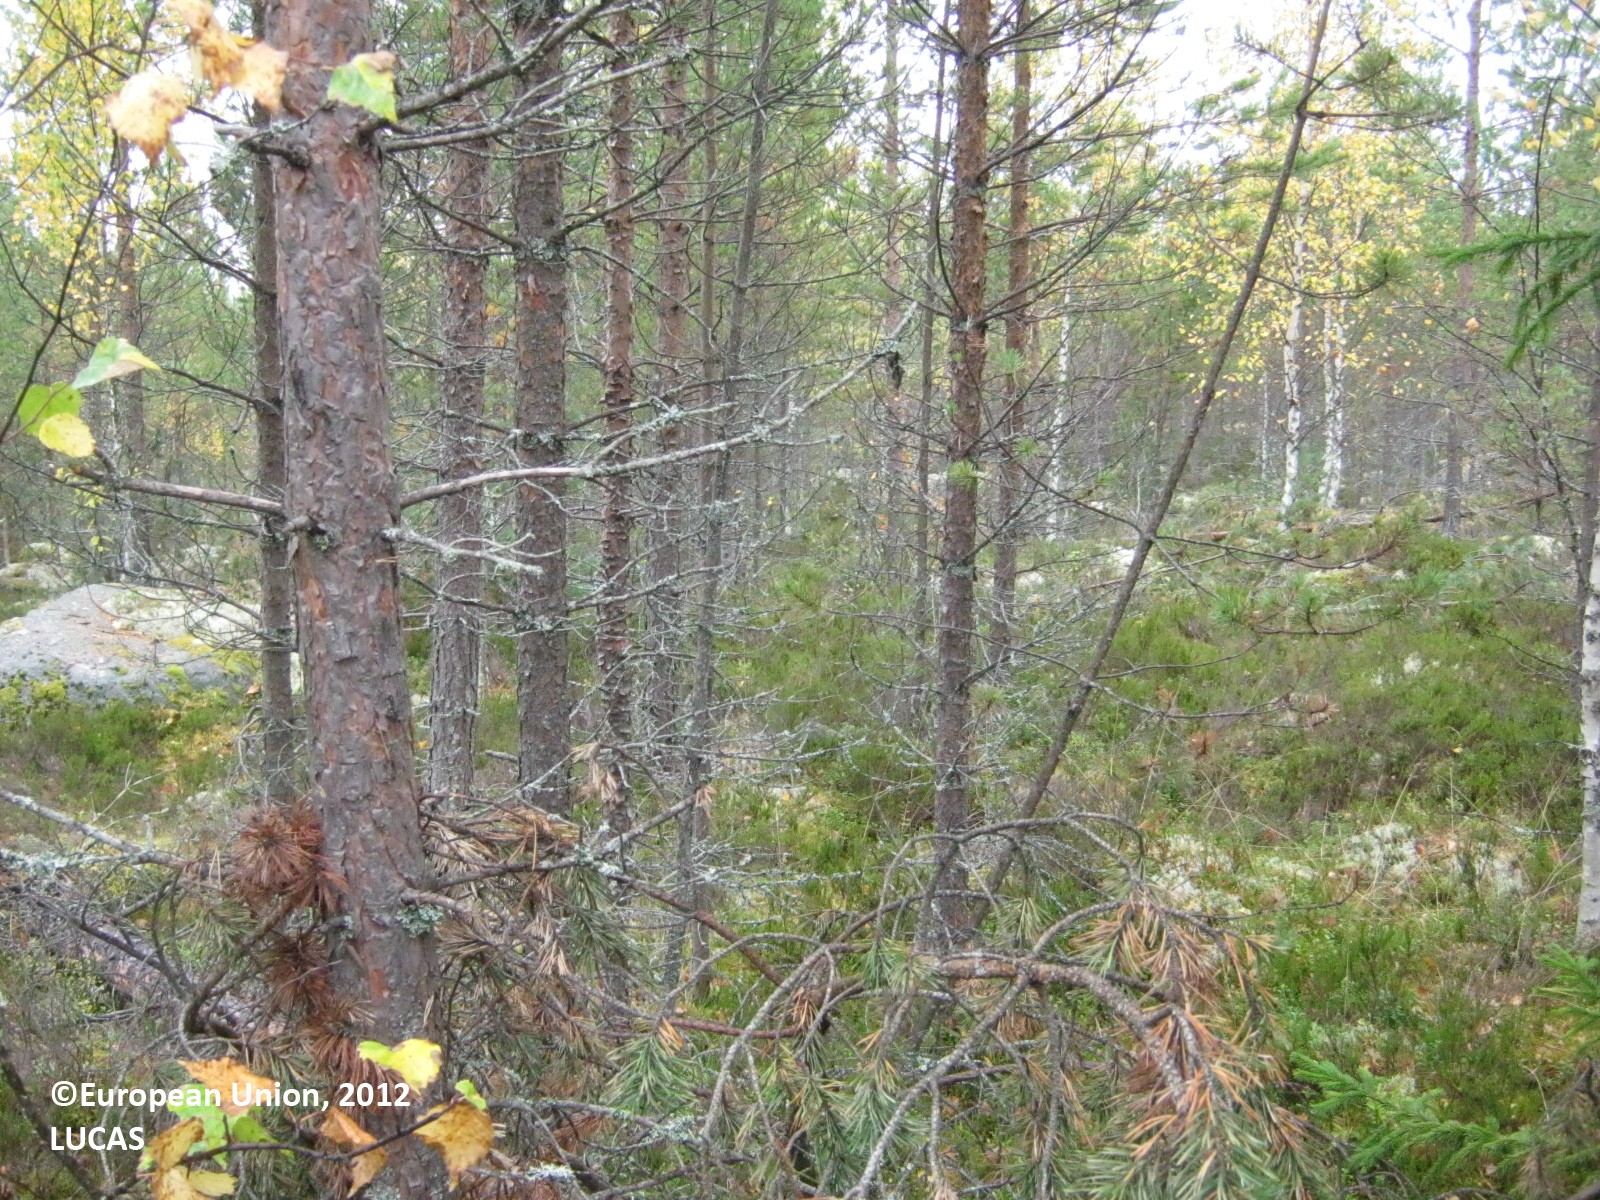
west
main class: Woodland
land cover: Pine dominated mixed woodland
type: boreal forest
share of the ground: > 75 %
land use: Forestry
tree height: > 5 m
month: September
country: FI
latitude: 63.4647
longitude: 26.0246
